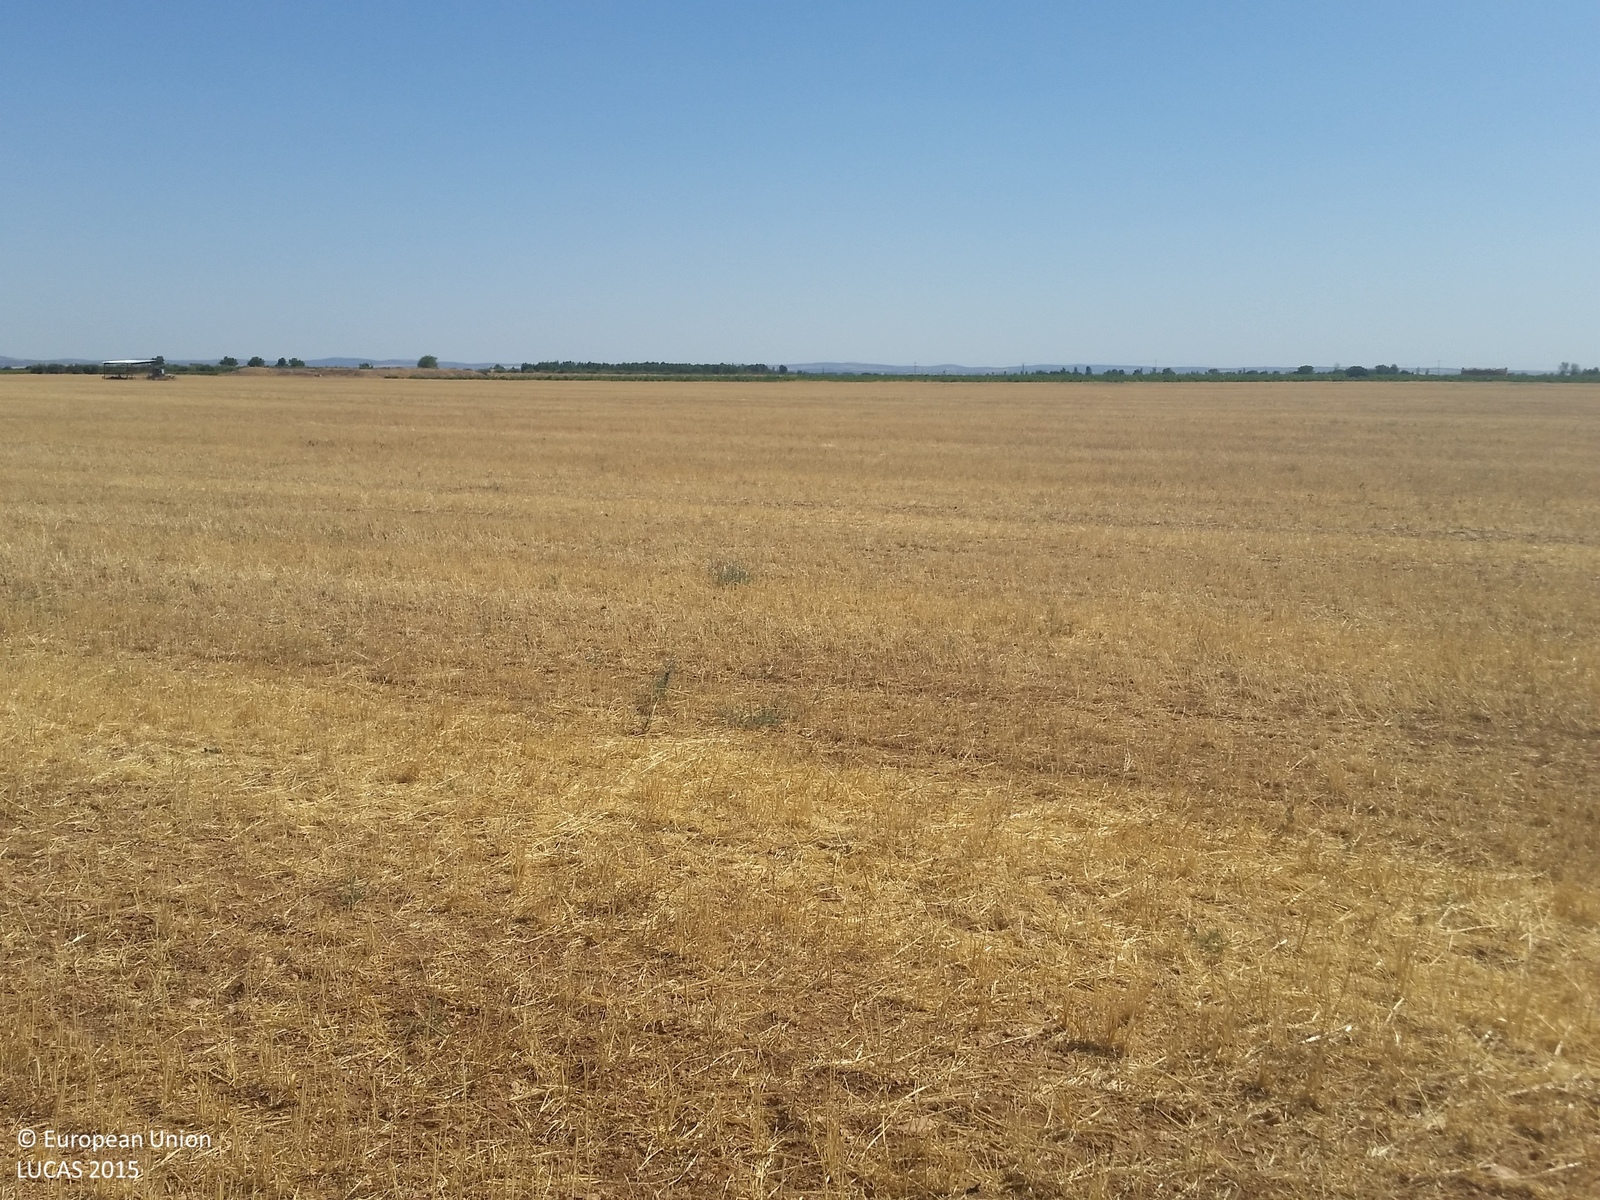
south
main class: Cropland
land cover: Barley
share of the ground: < 10 %
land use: Agriculture (excluding fallow land and kitchen gardens)
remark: Harvested field
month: July
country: ES
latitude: 39.2672
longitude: -2.7493
